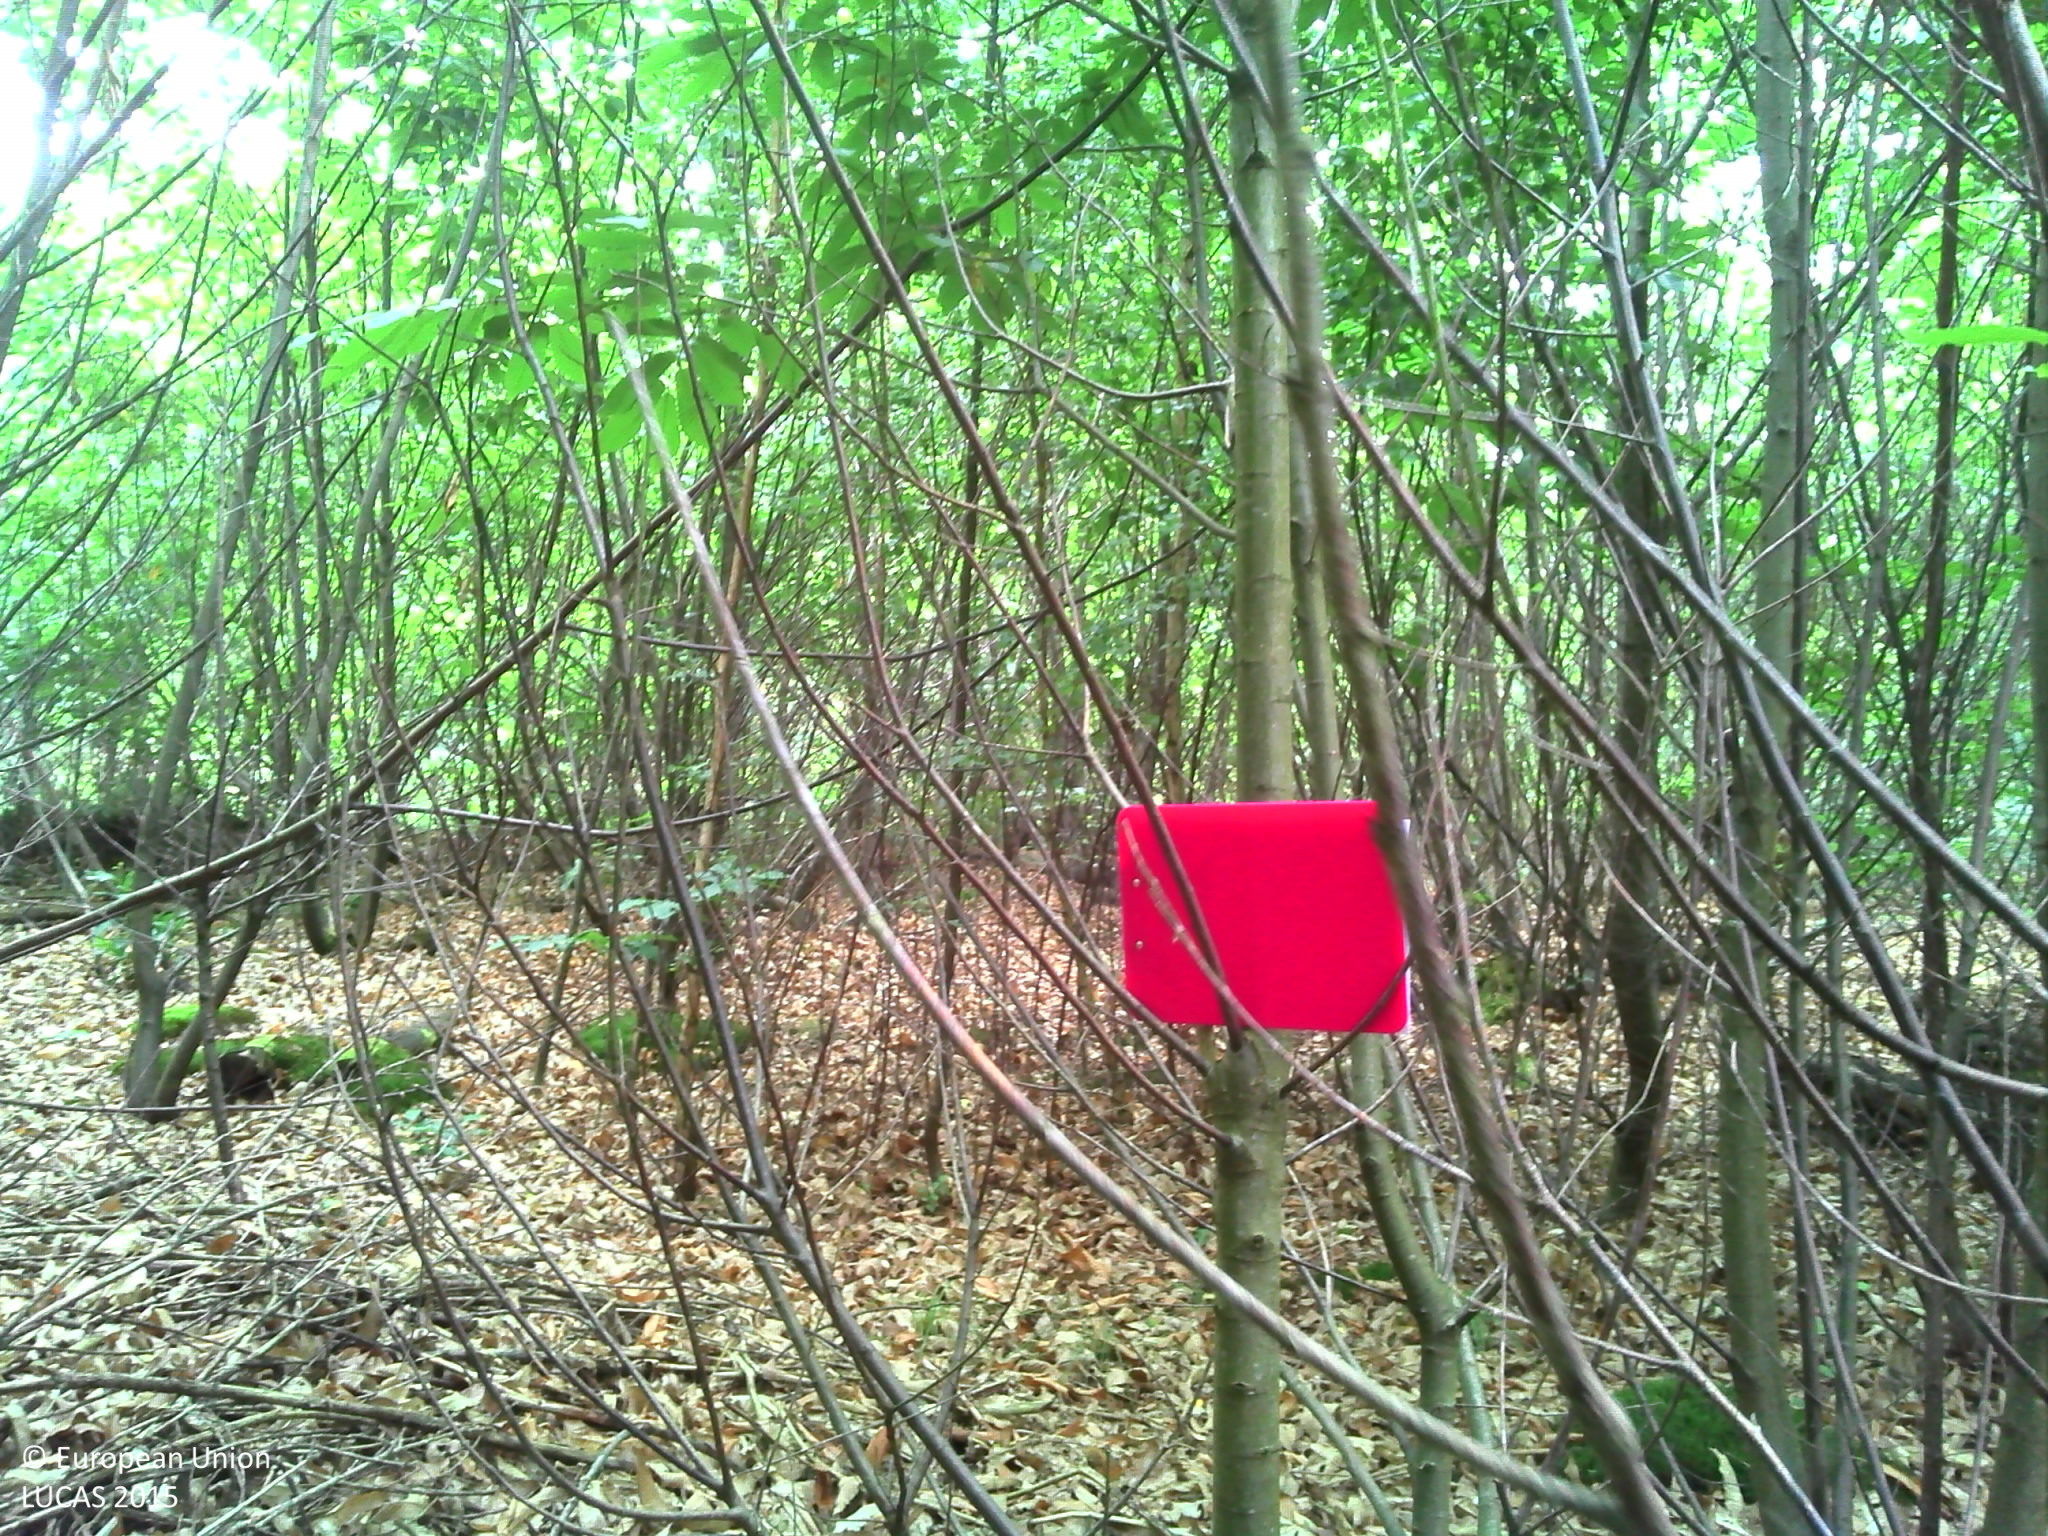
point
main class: Woodland
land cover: Broadleaved woodland
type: thermophilous deciduous forest
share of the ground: > 75 %
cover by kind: broadleaved forest trees 90 %, herbaceous plants 5 %, lichens and mosses 5 %
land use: Forestry
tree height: > 5 m
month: July
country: FR
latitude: 47.8017
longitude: -2.0008
